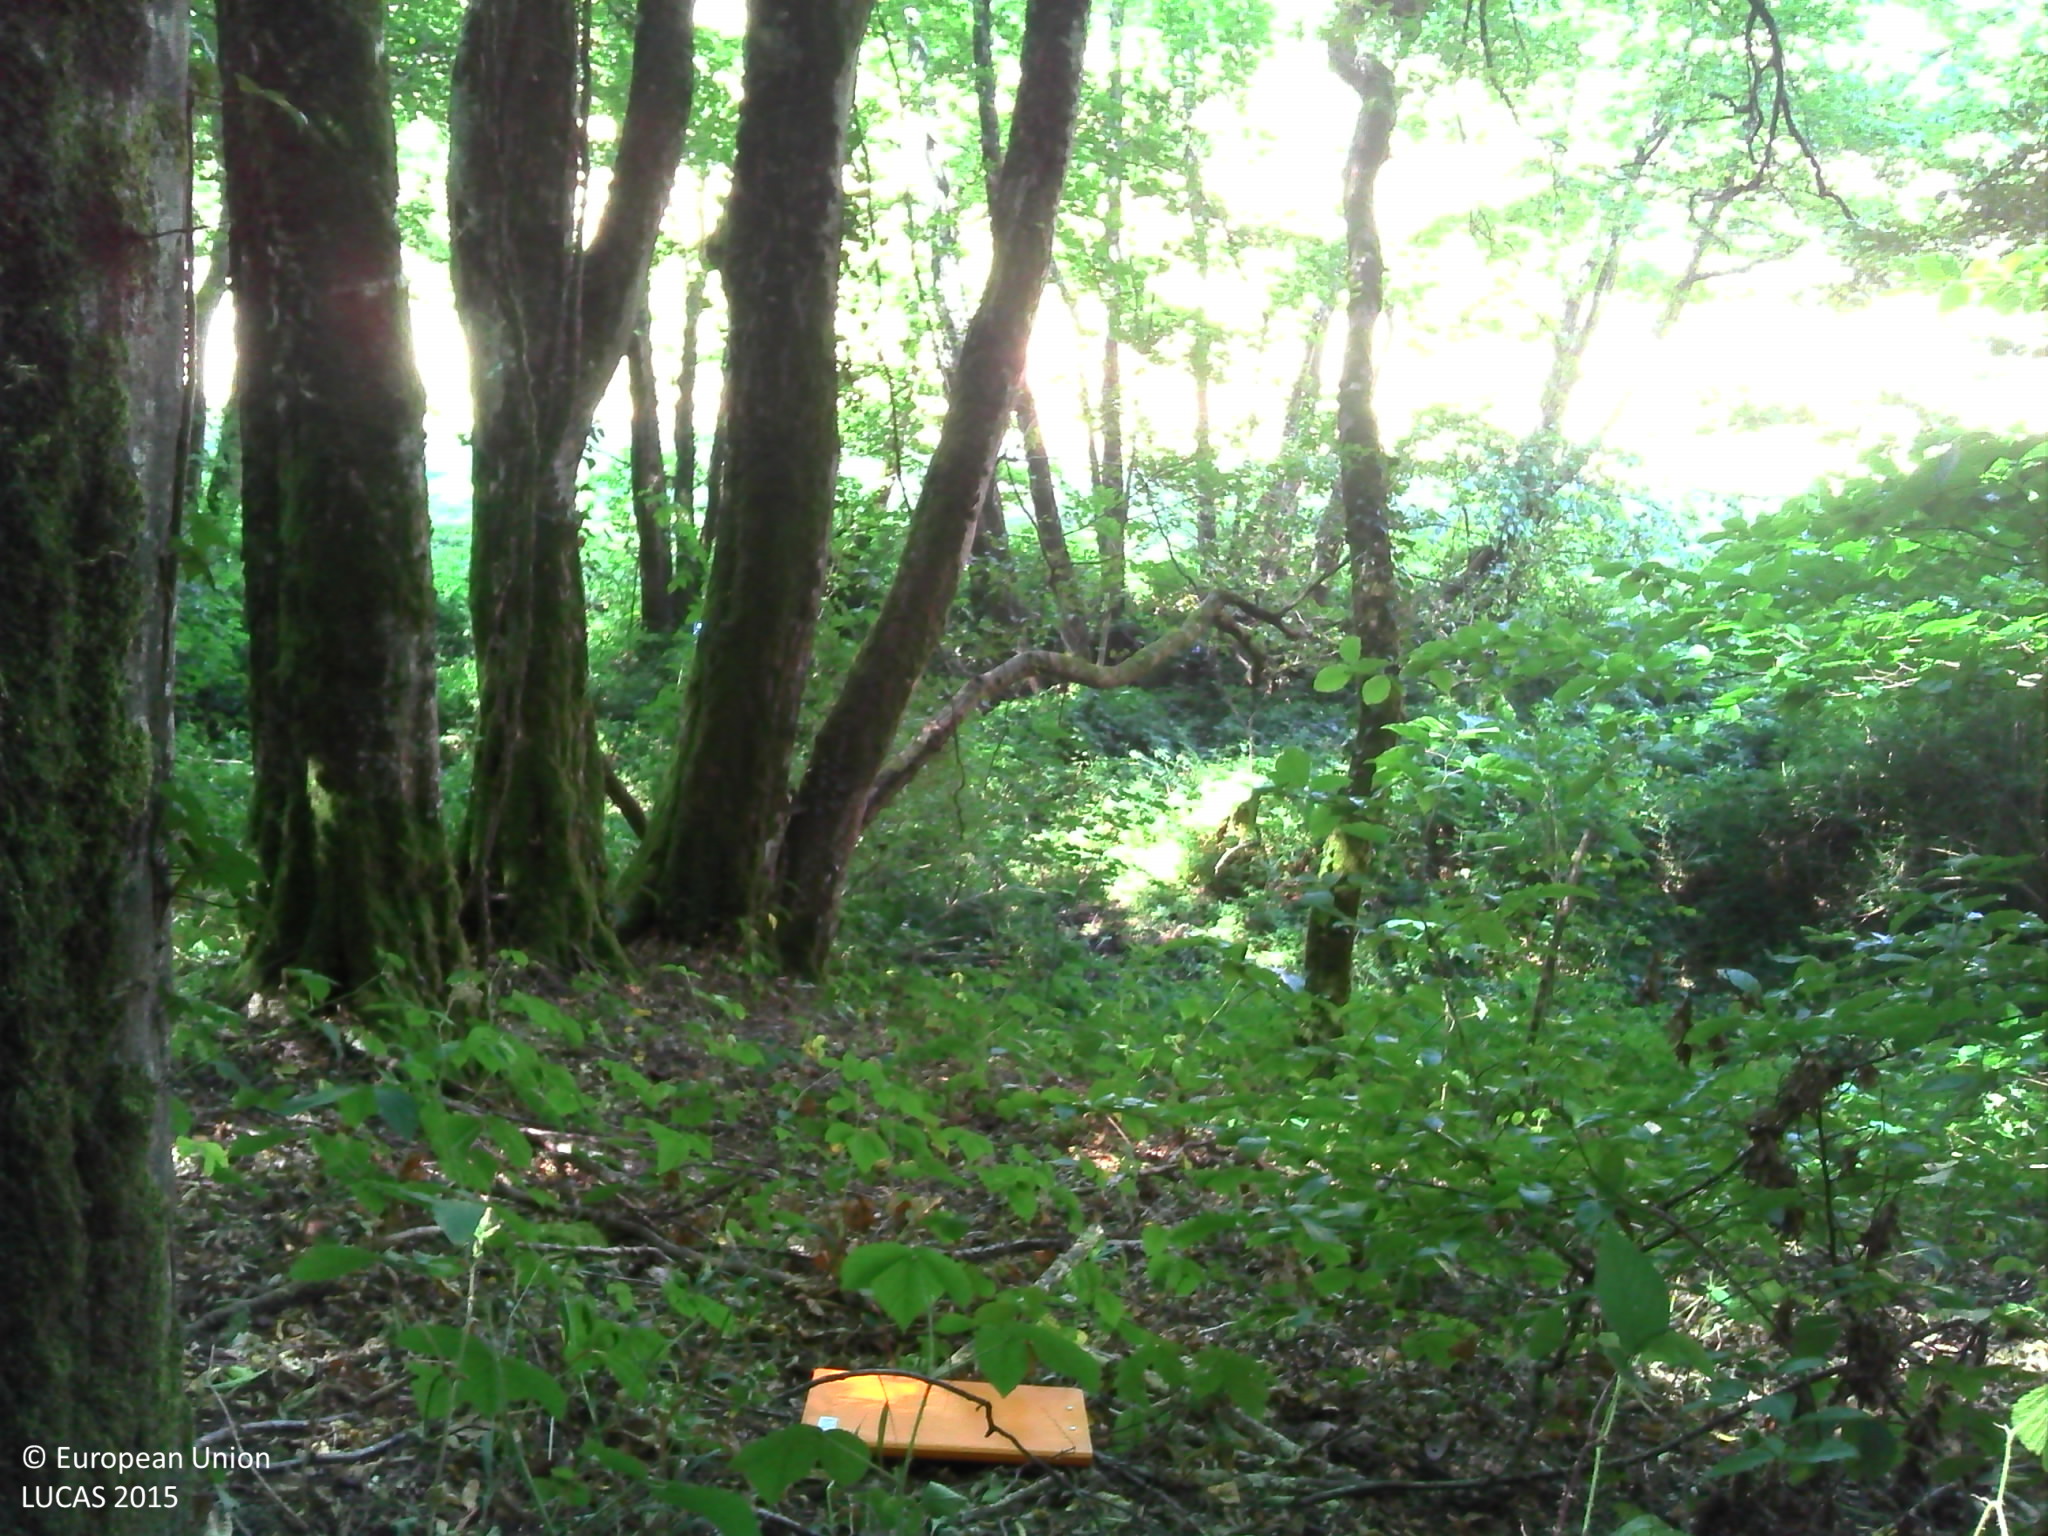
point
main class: Woodland
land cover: Broadleaved woodland
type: mesophytic deciduous forest
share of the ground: > 75 %
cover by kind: broadleaved forest trees 100 %
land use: Forestry
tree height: > 5 m
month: July
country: FR
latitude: 46.8168
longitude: 4.0361
